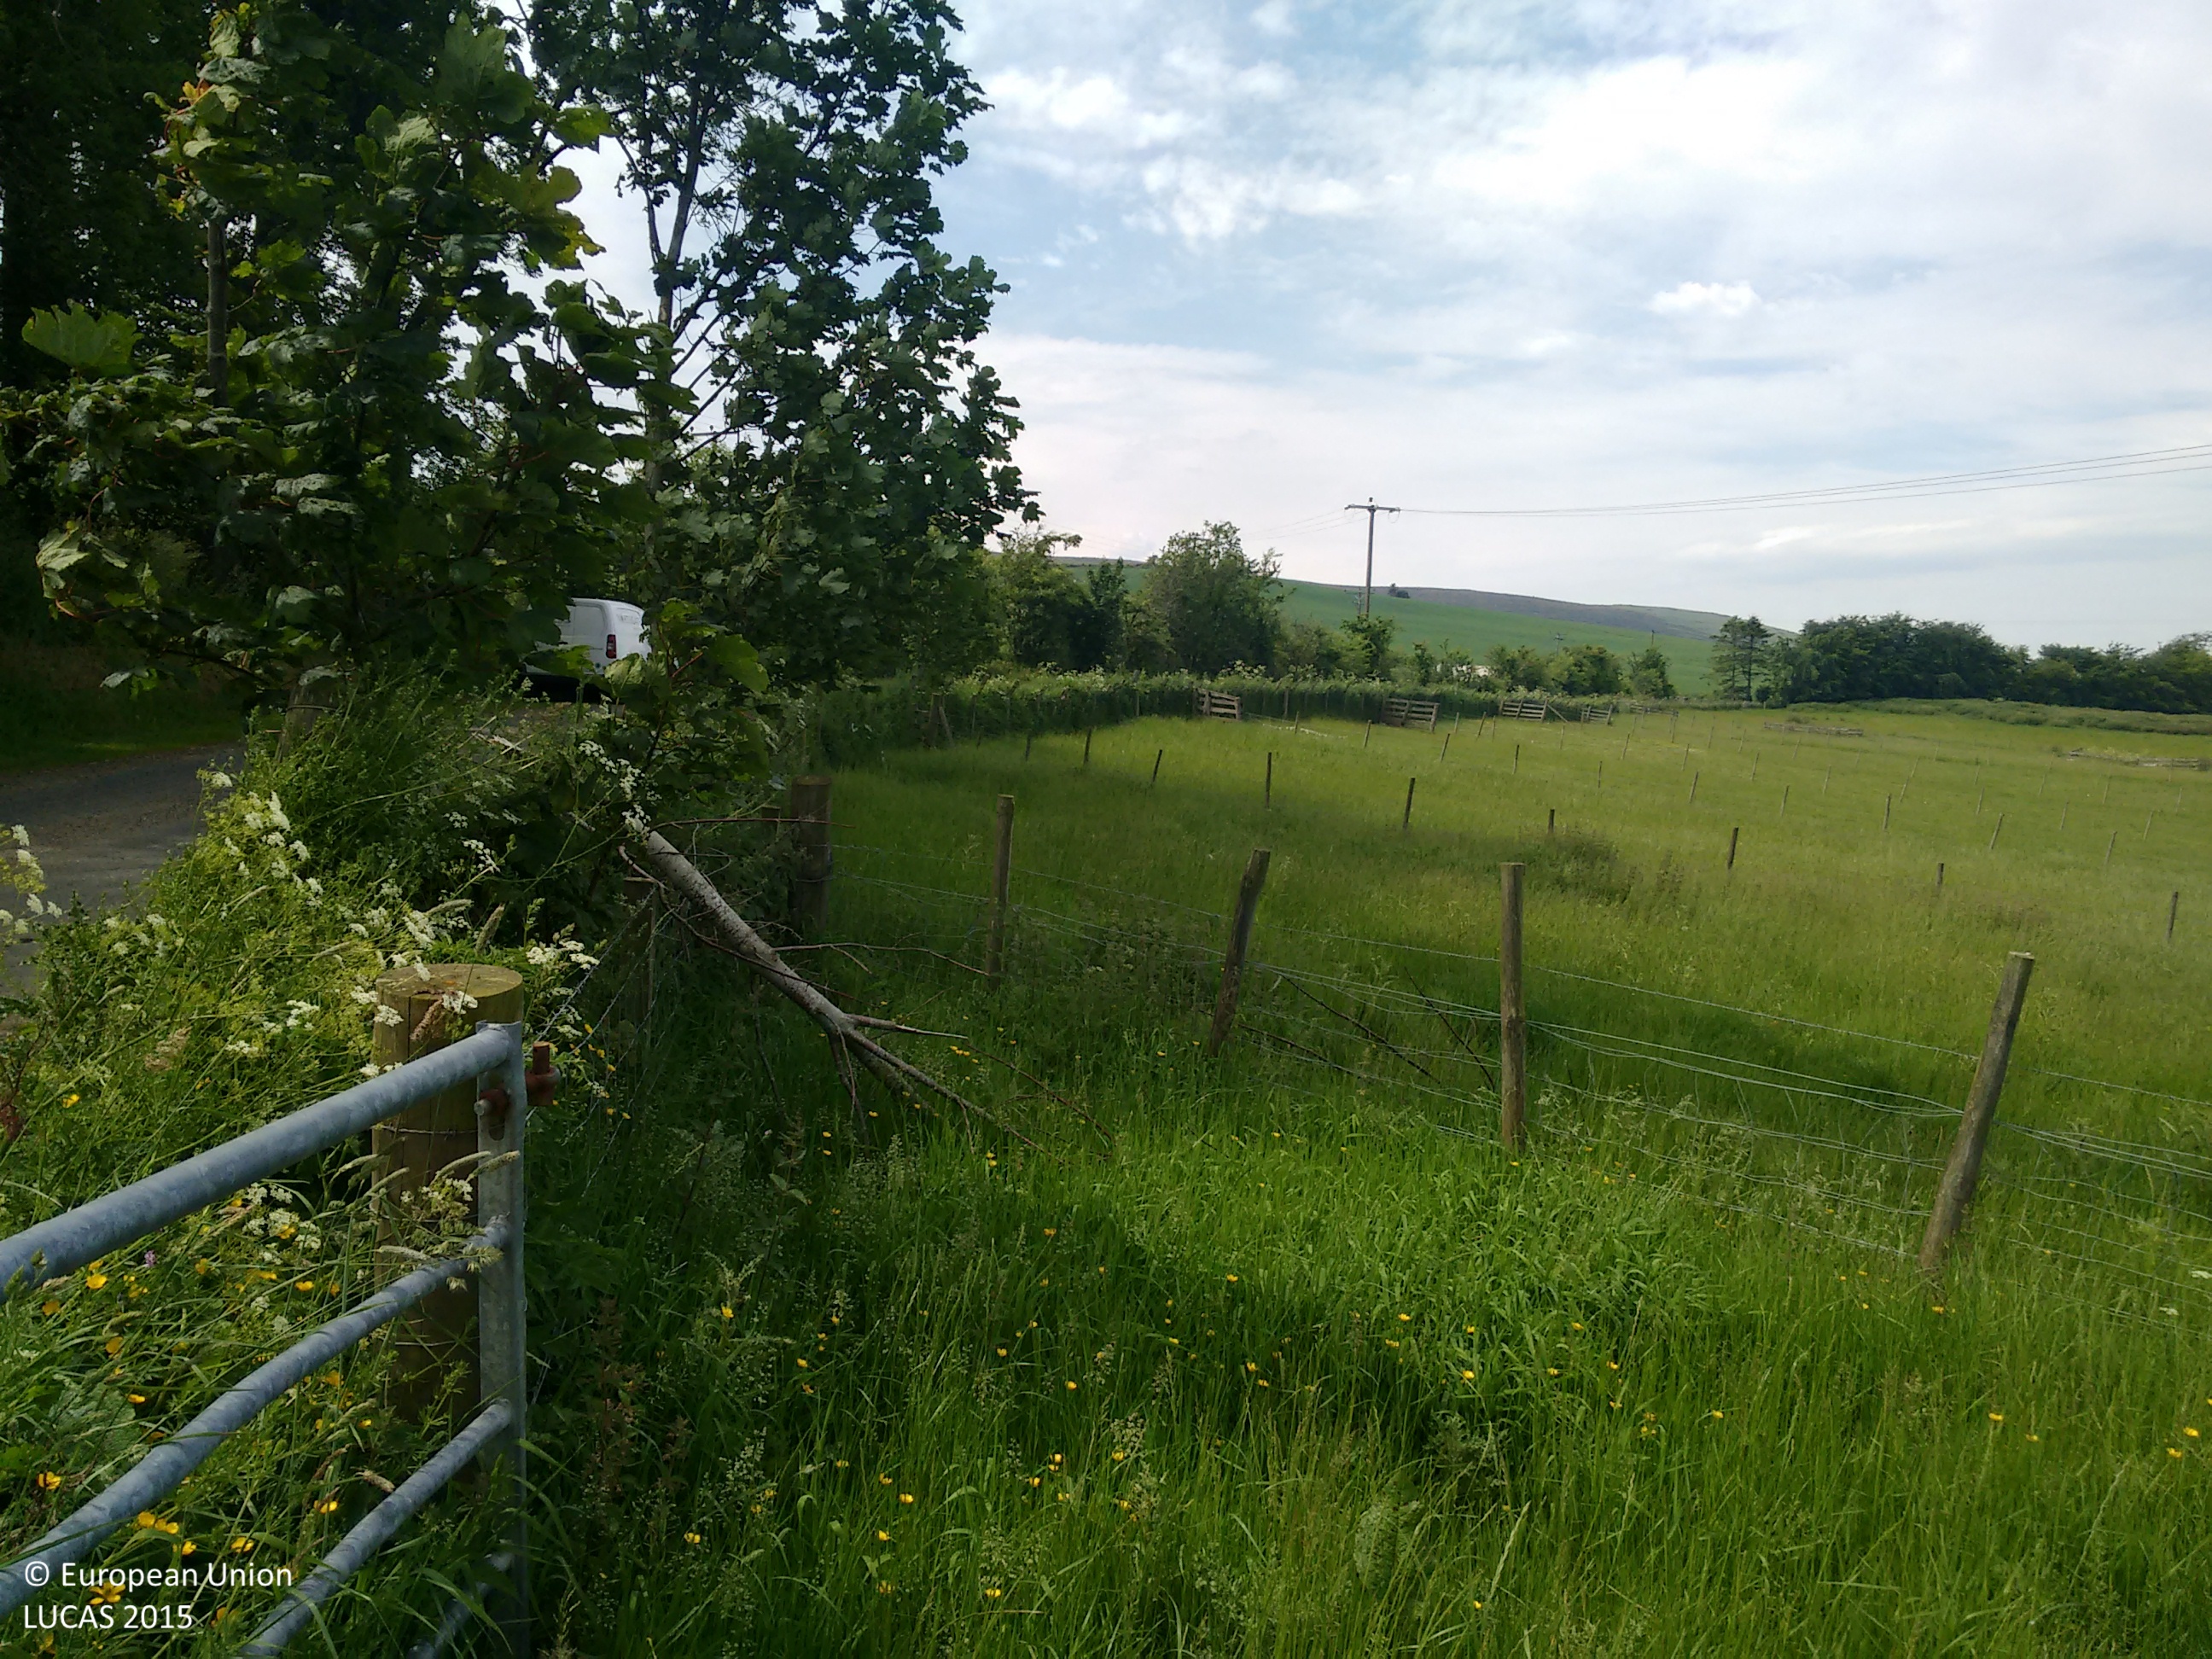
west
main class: Grassland
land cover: Grassland without tree/shrub cover
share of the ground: > 75 %
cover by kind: herbaceous plants 100 %
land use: Agriculture (excluding fallow land and kitchen gardens)
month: July
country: GB
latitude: 57.4397
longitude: -2.8028
